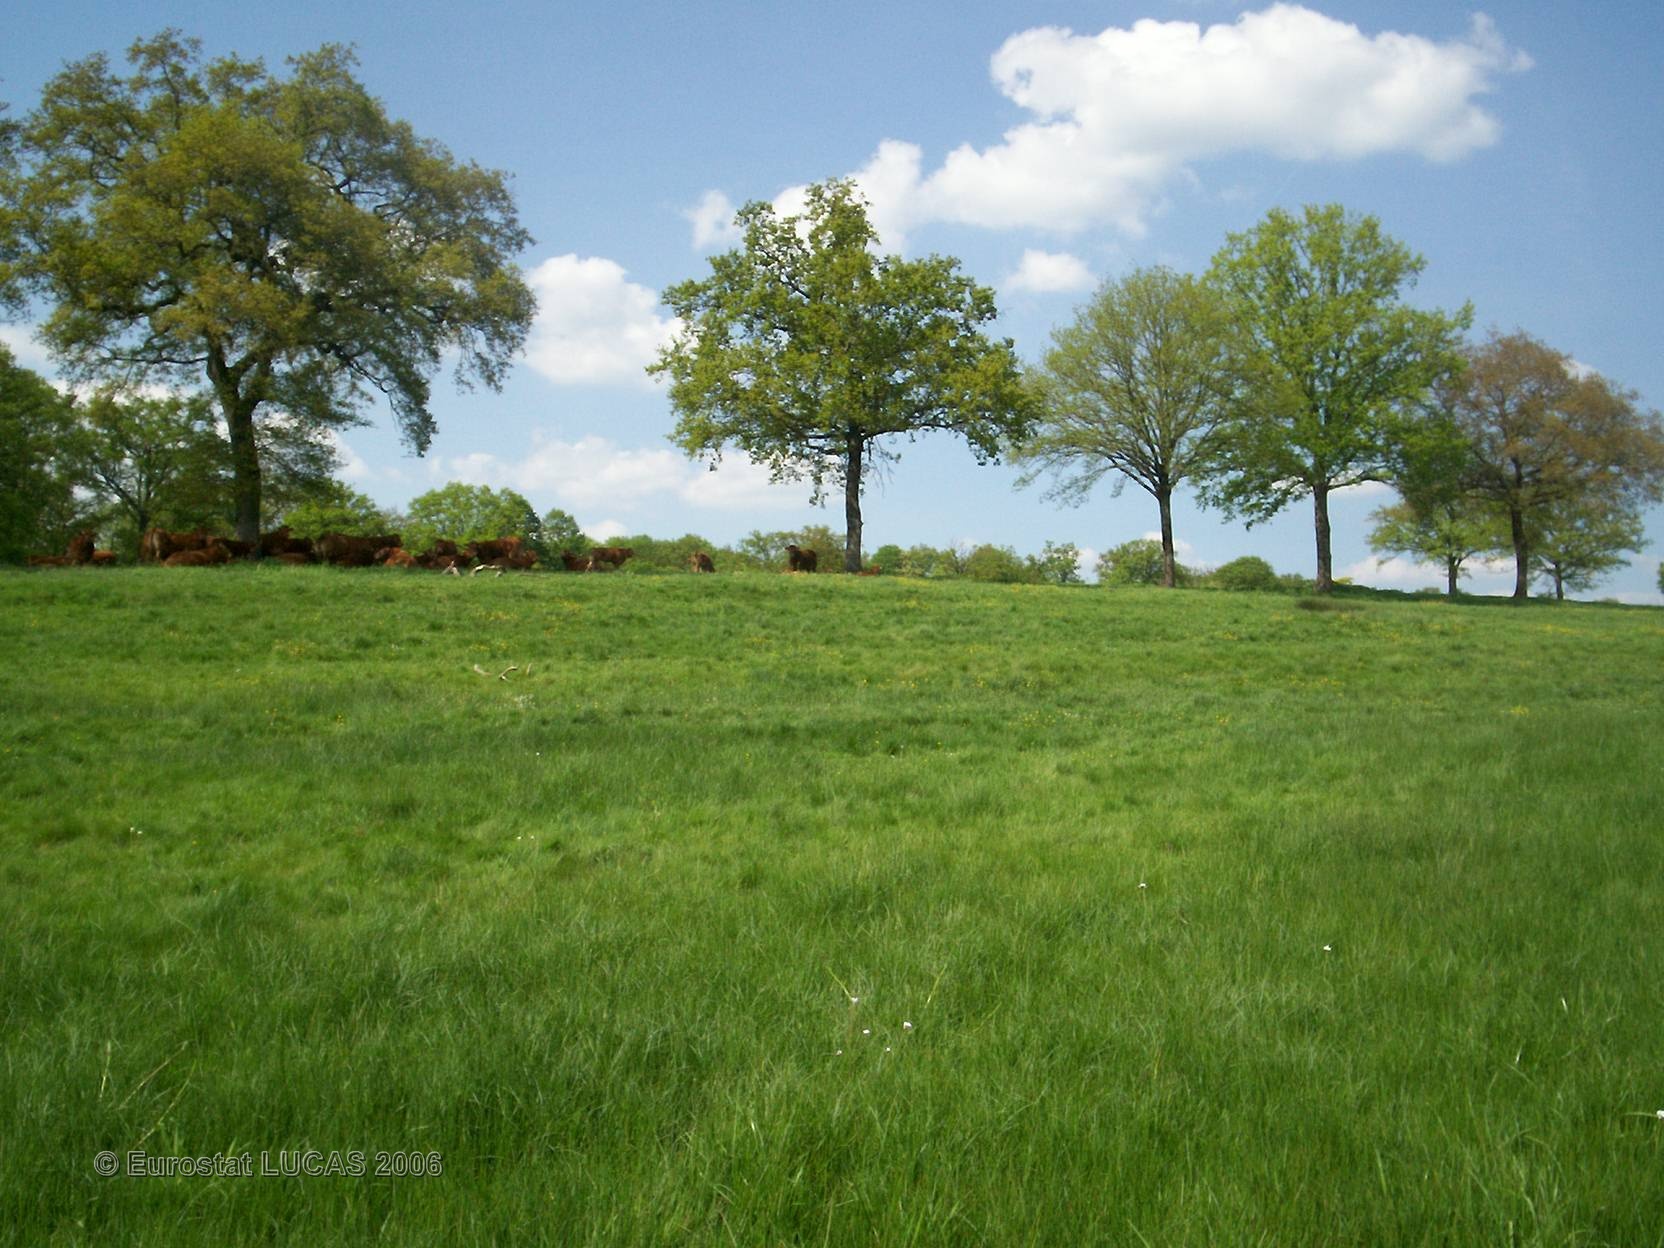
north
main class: Grassland
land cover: Grassland without tree/shrub cover
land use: Agriculture (excluding fallow land and kitchen gardens)
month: May
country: FR
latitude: 45.9463
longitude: 0.7115
